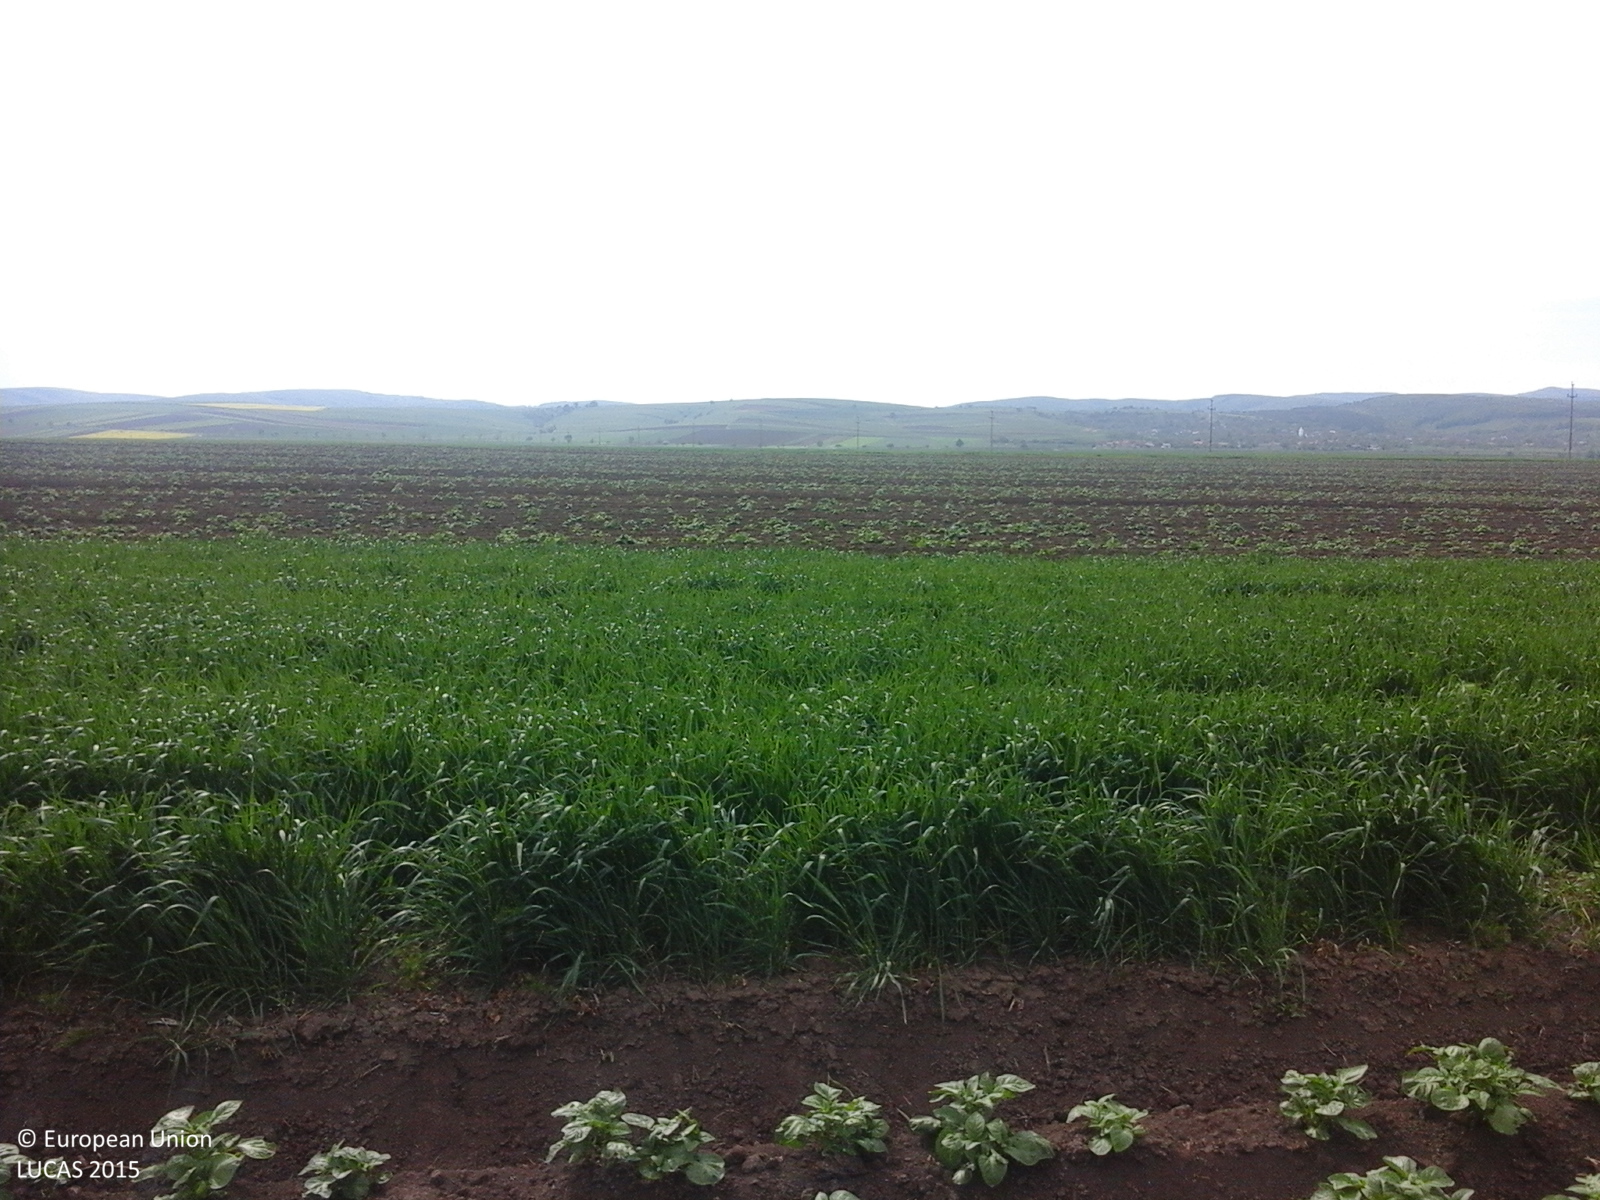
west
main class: Cropland
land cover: Potatoes
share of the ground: 10 - 25 %
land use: Agriculture (excluding fallow land and kitchen gardens)
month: May
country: RO
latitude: 45.9195
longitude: 26.0412
